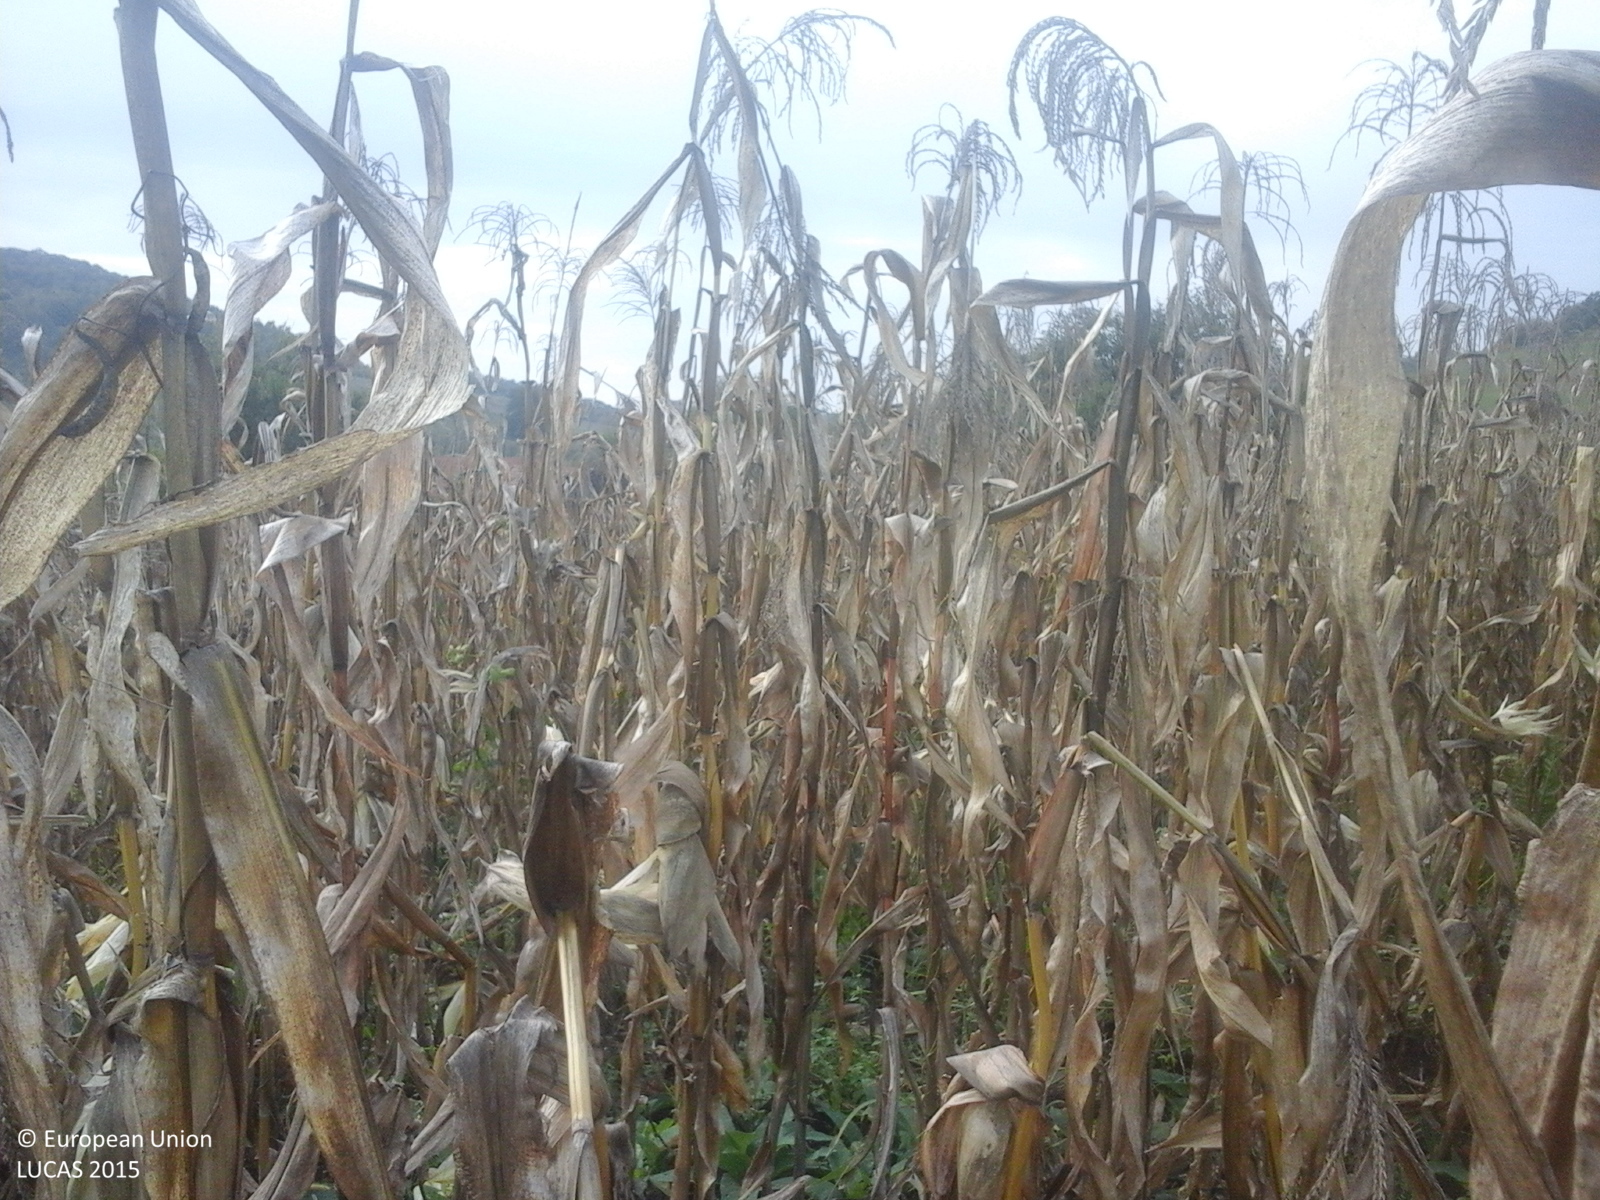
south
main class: Cropland
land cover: Maize
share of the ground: > 75 %
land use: Agriculture (excluding fallow land and kitchen gardens)
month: October
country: RO
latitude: 46.4997
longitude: 24.8309
